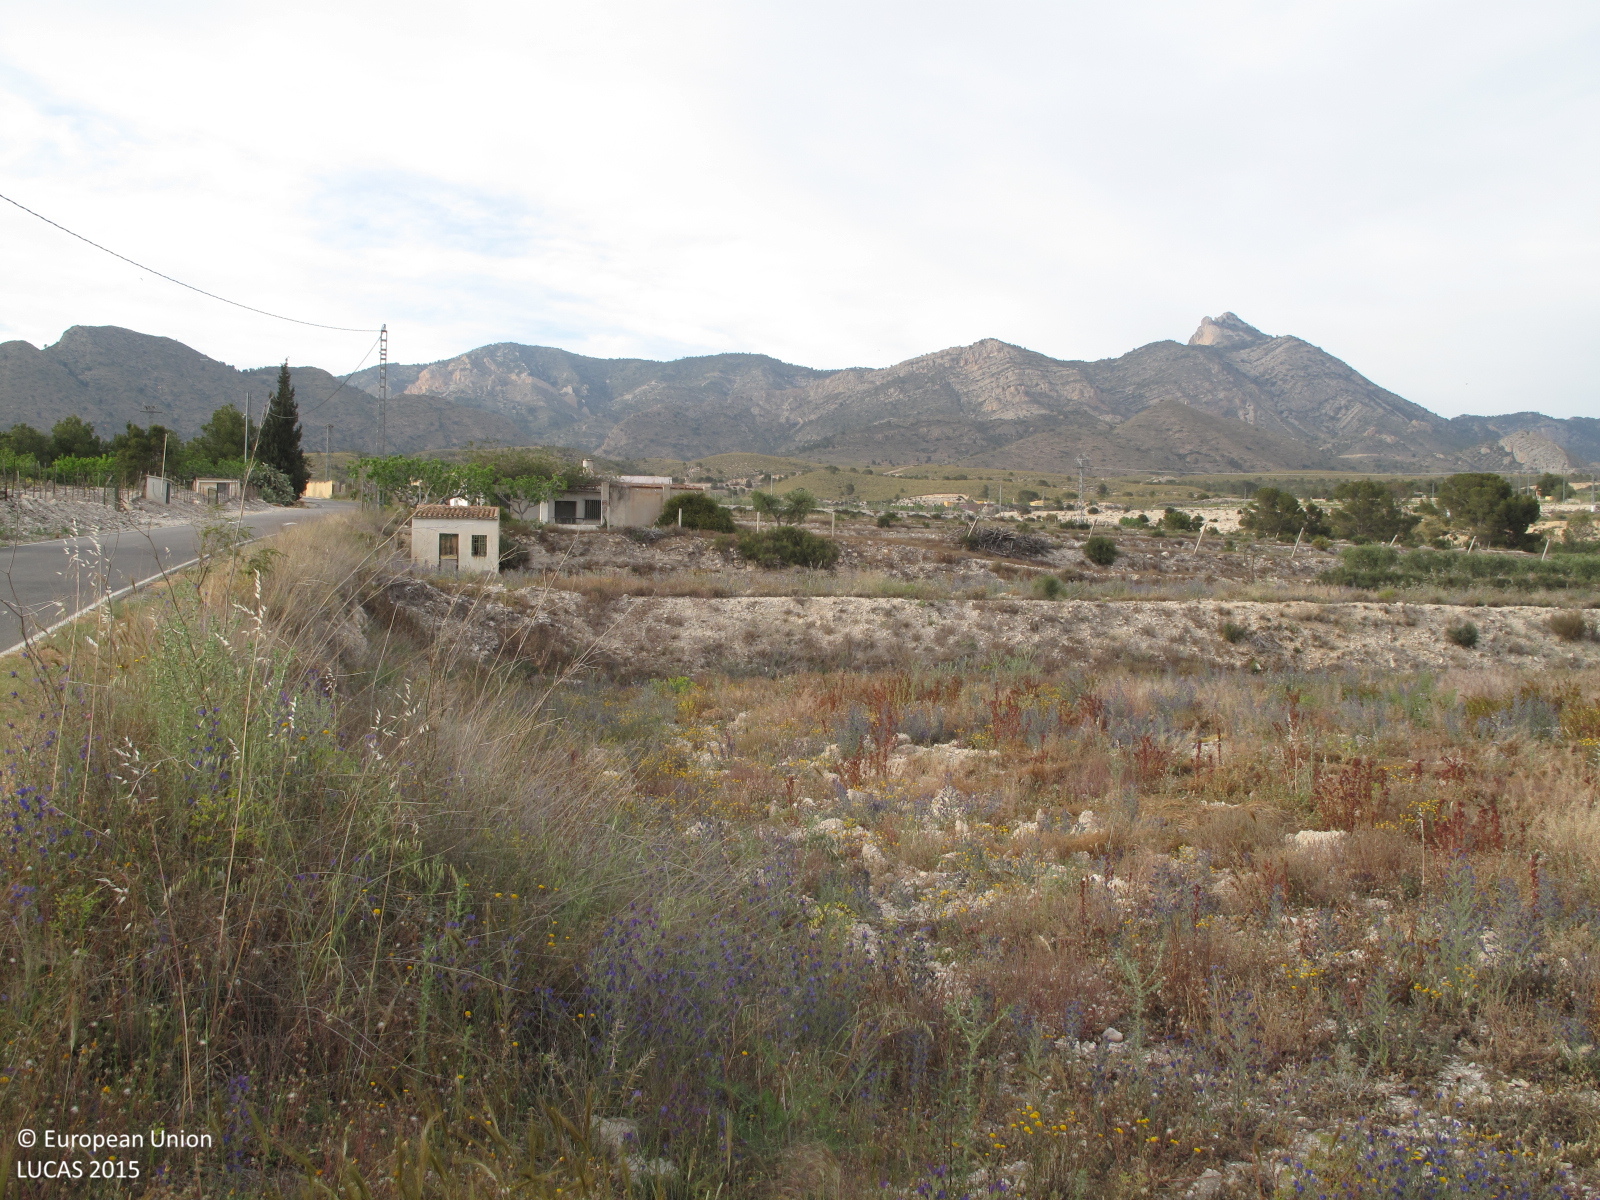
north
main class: Grassland
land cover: Spontaneously vegetated surfaces
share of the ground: > 75 %
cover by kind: herbaceous plants 80 %, unconsolidated bare surface 20 %
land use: Abandoned areas
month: April
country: ES
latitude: 38.4625
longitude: -0.6571
